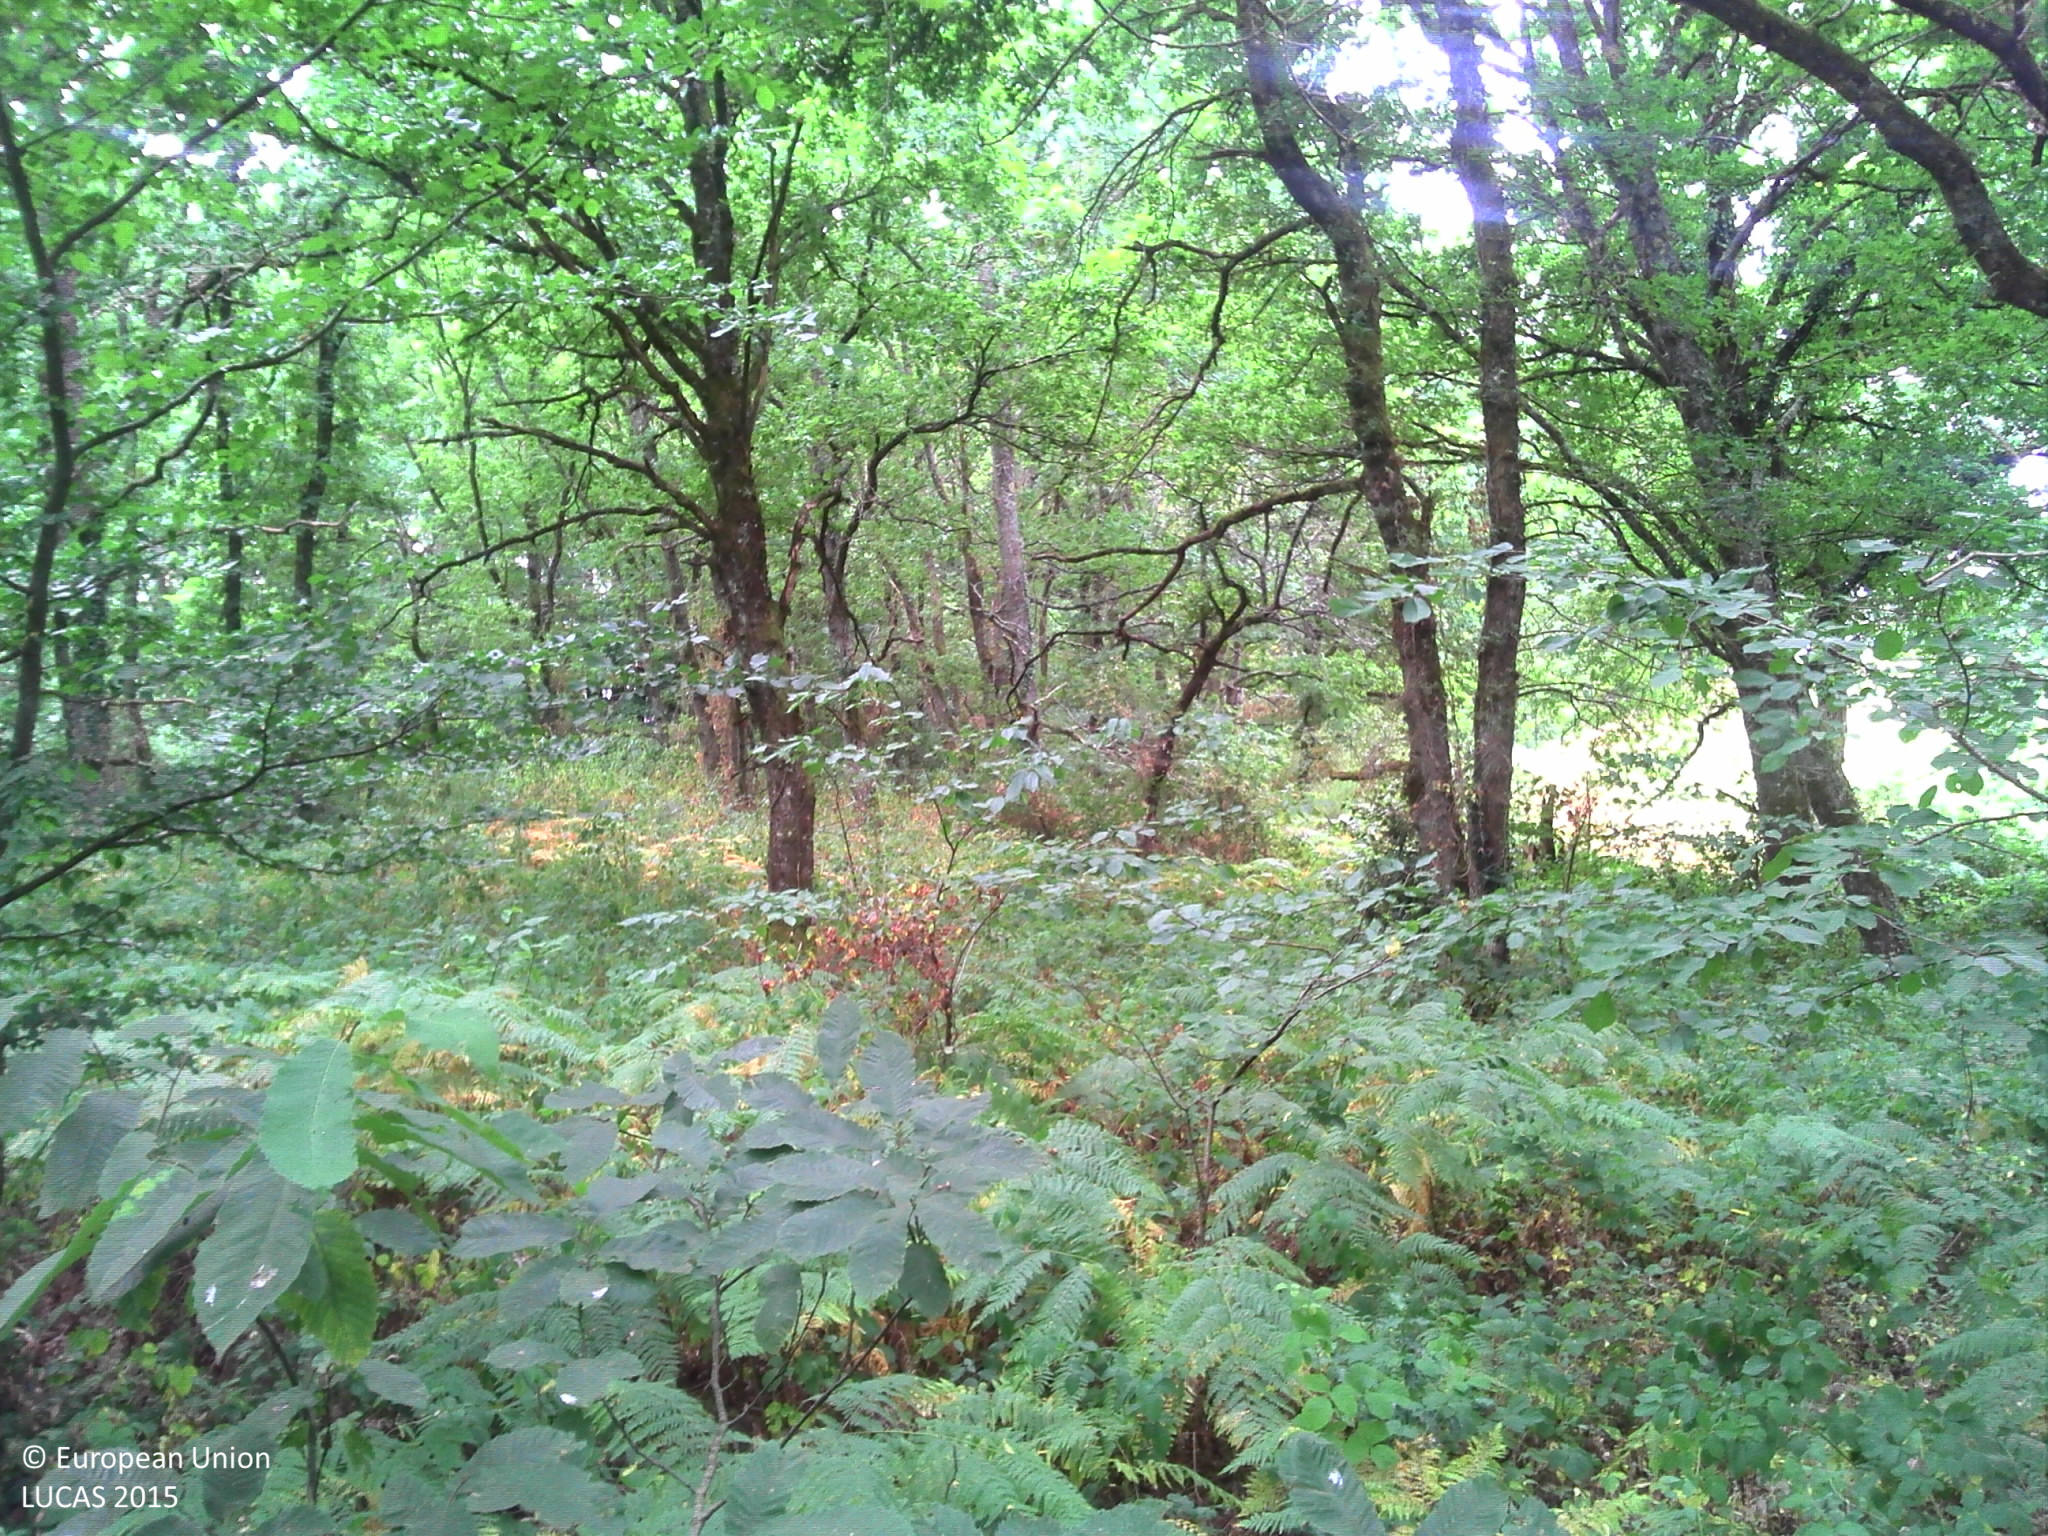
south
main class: Woodland
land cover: Broadleaved woodland
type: mesophytic deciduous forest
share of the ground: > 75 %
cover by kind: broadleaved forest trees 85 %, herbaceous plants 10 %, shrubs 5 %
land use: Forestry
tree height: > 5 m
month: July
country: FR
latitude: 46.4006
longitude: 1.6014
